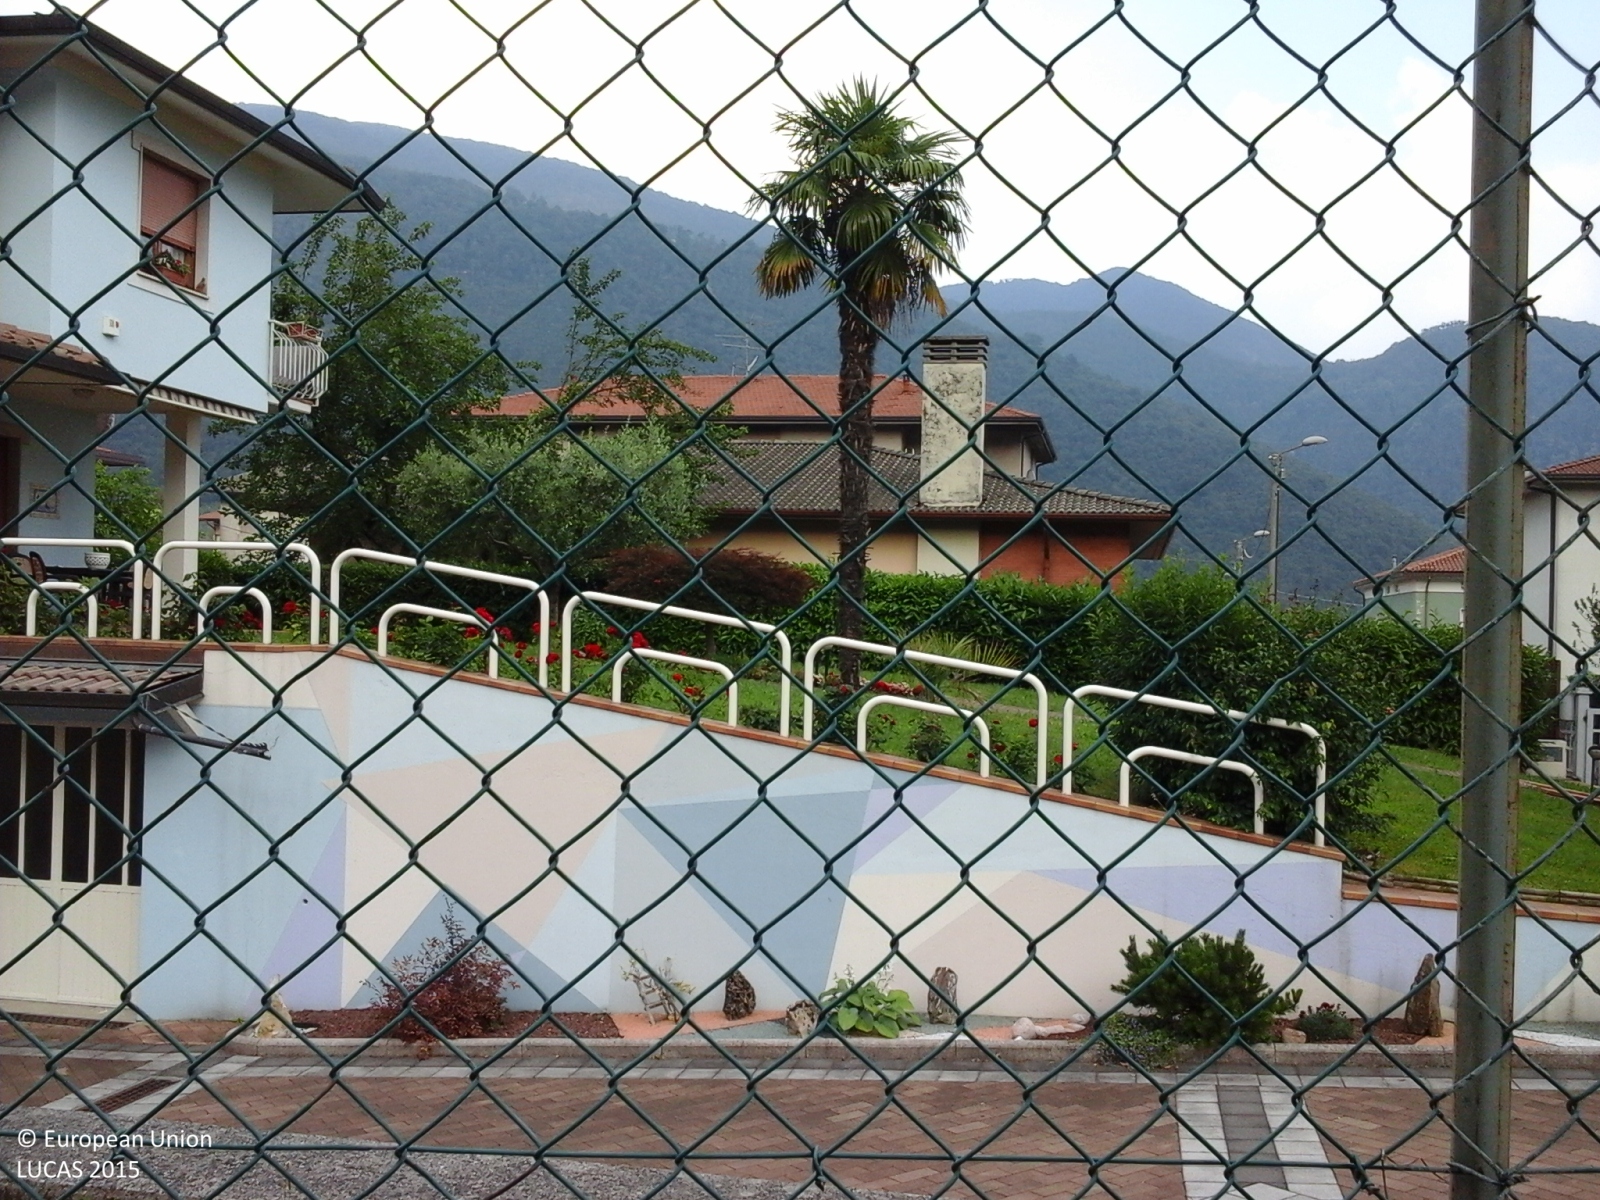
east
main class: Grassland
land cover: Grassland with sparse tree/shrub cover
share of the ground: > 75 %
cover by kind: herbaceous plants 95 %, coniferous forest trees 5 %
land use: Residential
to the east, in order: Grassland with sparse tree/shrub cover; Artificial constructions in urban areas
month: June
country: IT
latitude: 45.6304
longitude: 10.1921
